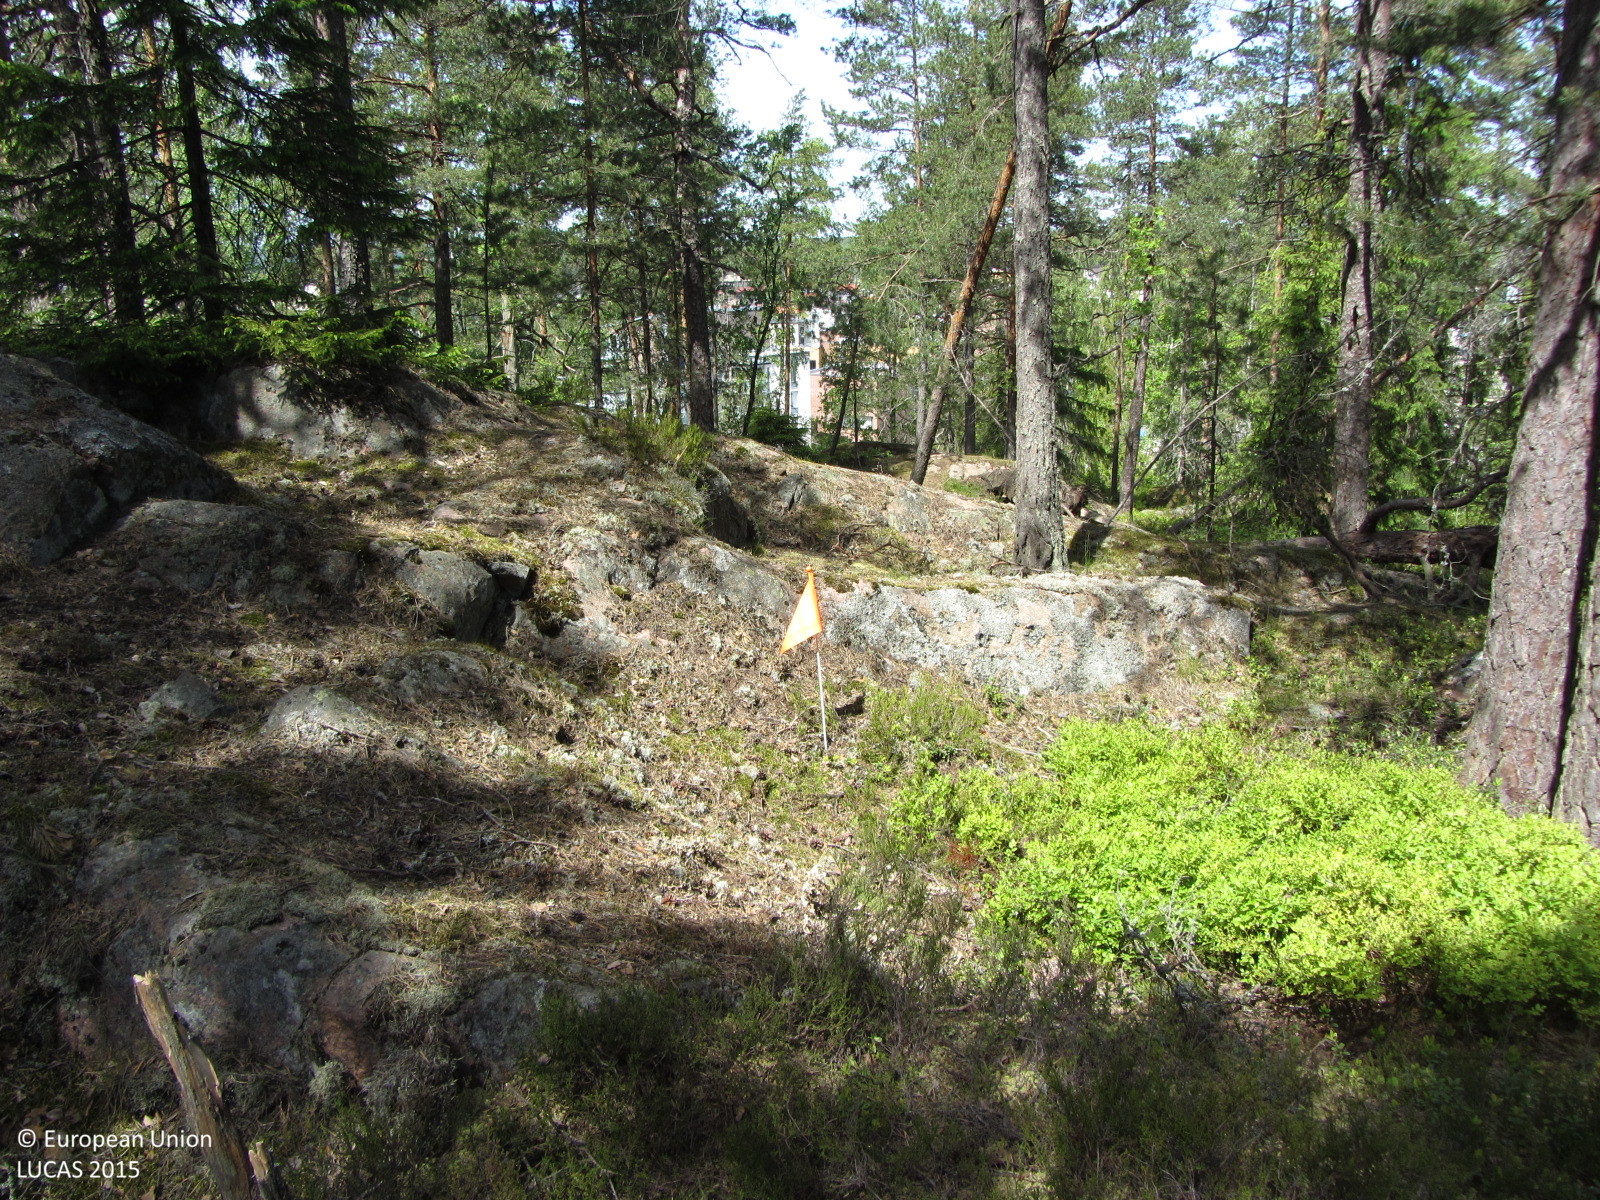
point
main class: Woodland
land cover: Pine dominated coniferous woodland
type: boreal forest
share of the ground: > 75 %
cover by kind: coniferous forest trees 70 %, shrubs 10 %, consolidated bare surface 10 %, broadleaved forest trees 5 %, lichens and mosses 5 %
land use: Forestry
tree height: > 5 m
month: June
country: FI
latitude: 60.1658
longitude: 24.6177
